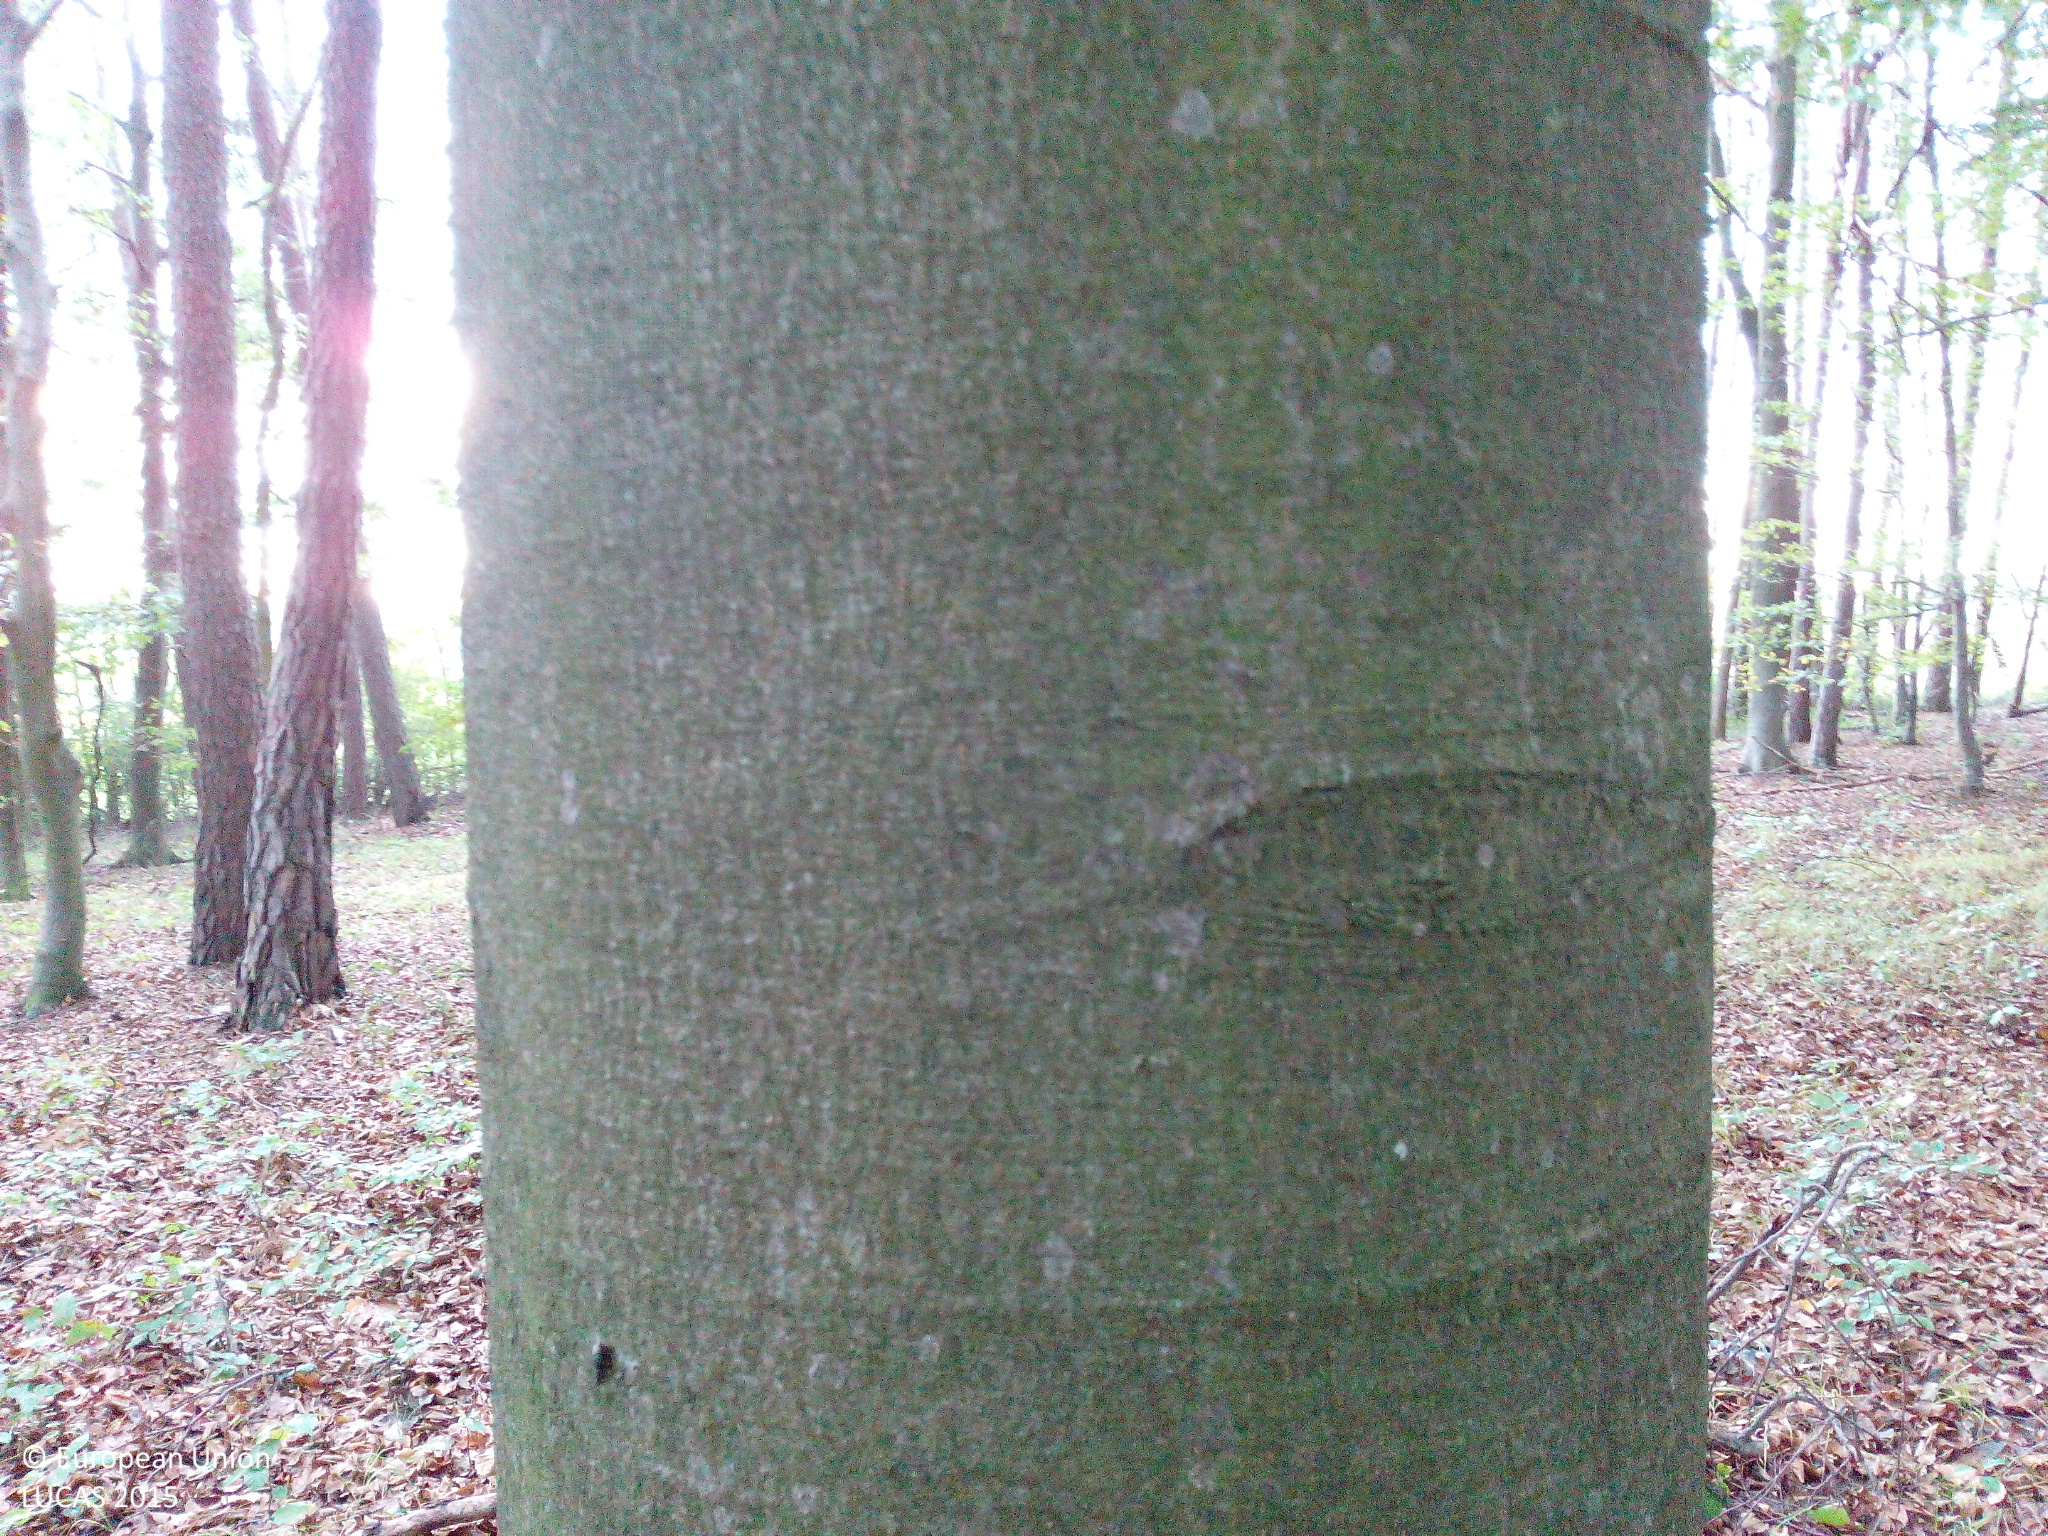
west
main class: Woodland
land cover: Pine dominated mixed woodland
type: hemiboreal forest and nemoral coniferous forest and mixed broadleaved-coniferous forest
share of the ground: > 75 %
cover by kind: broadleaved forest trees 45 %, coniferous forest trees 35 %, herbaceous plants 10 %, unconsolidated bare surface 10 %
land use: Forestry
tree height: > 5 m
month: September
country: DE
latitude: 49.9324
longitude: 9.9025
